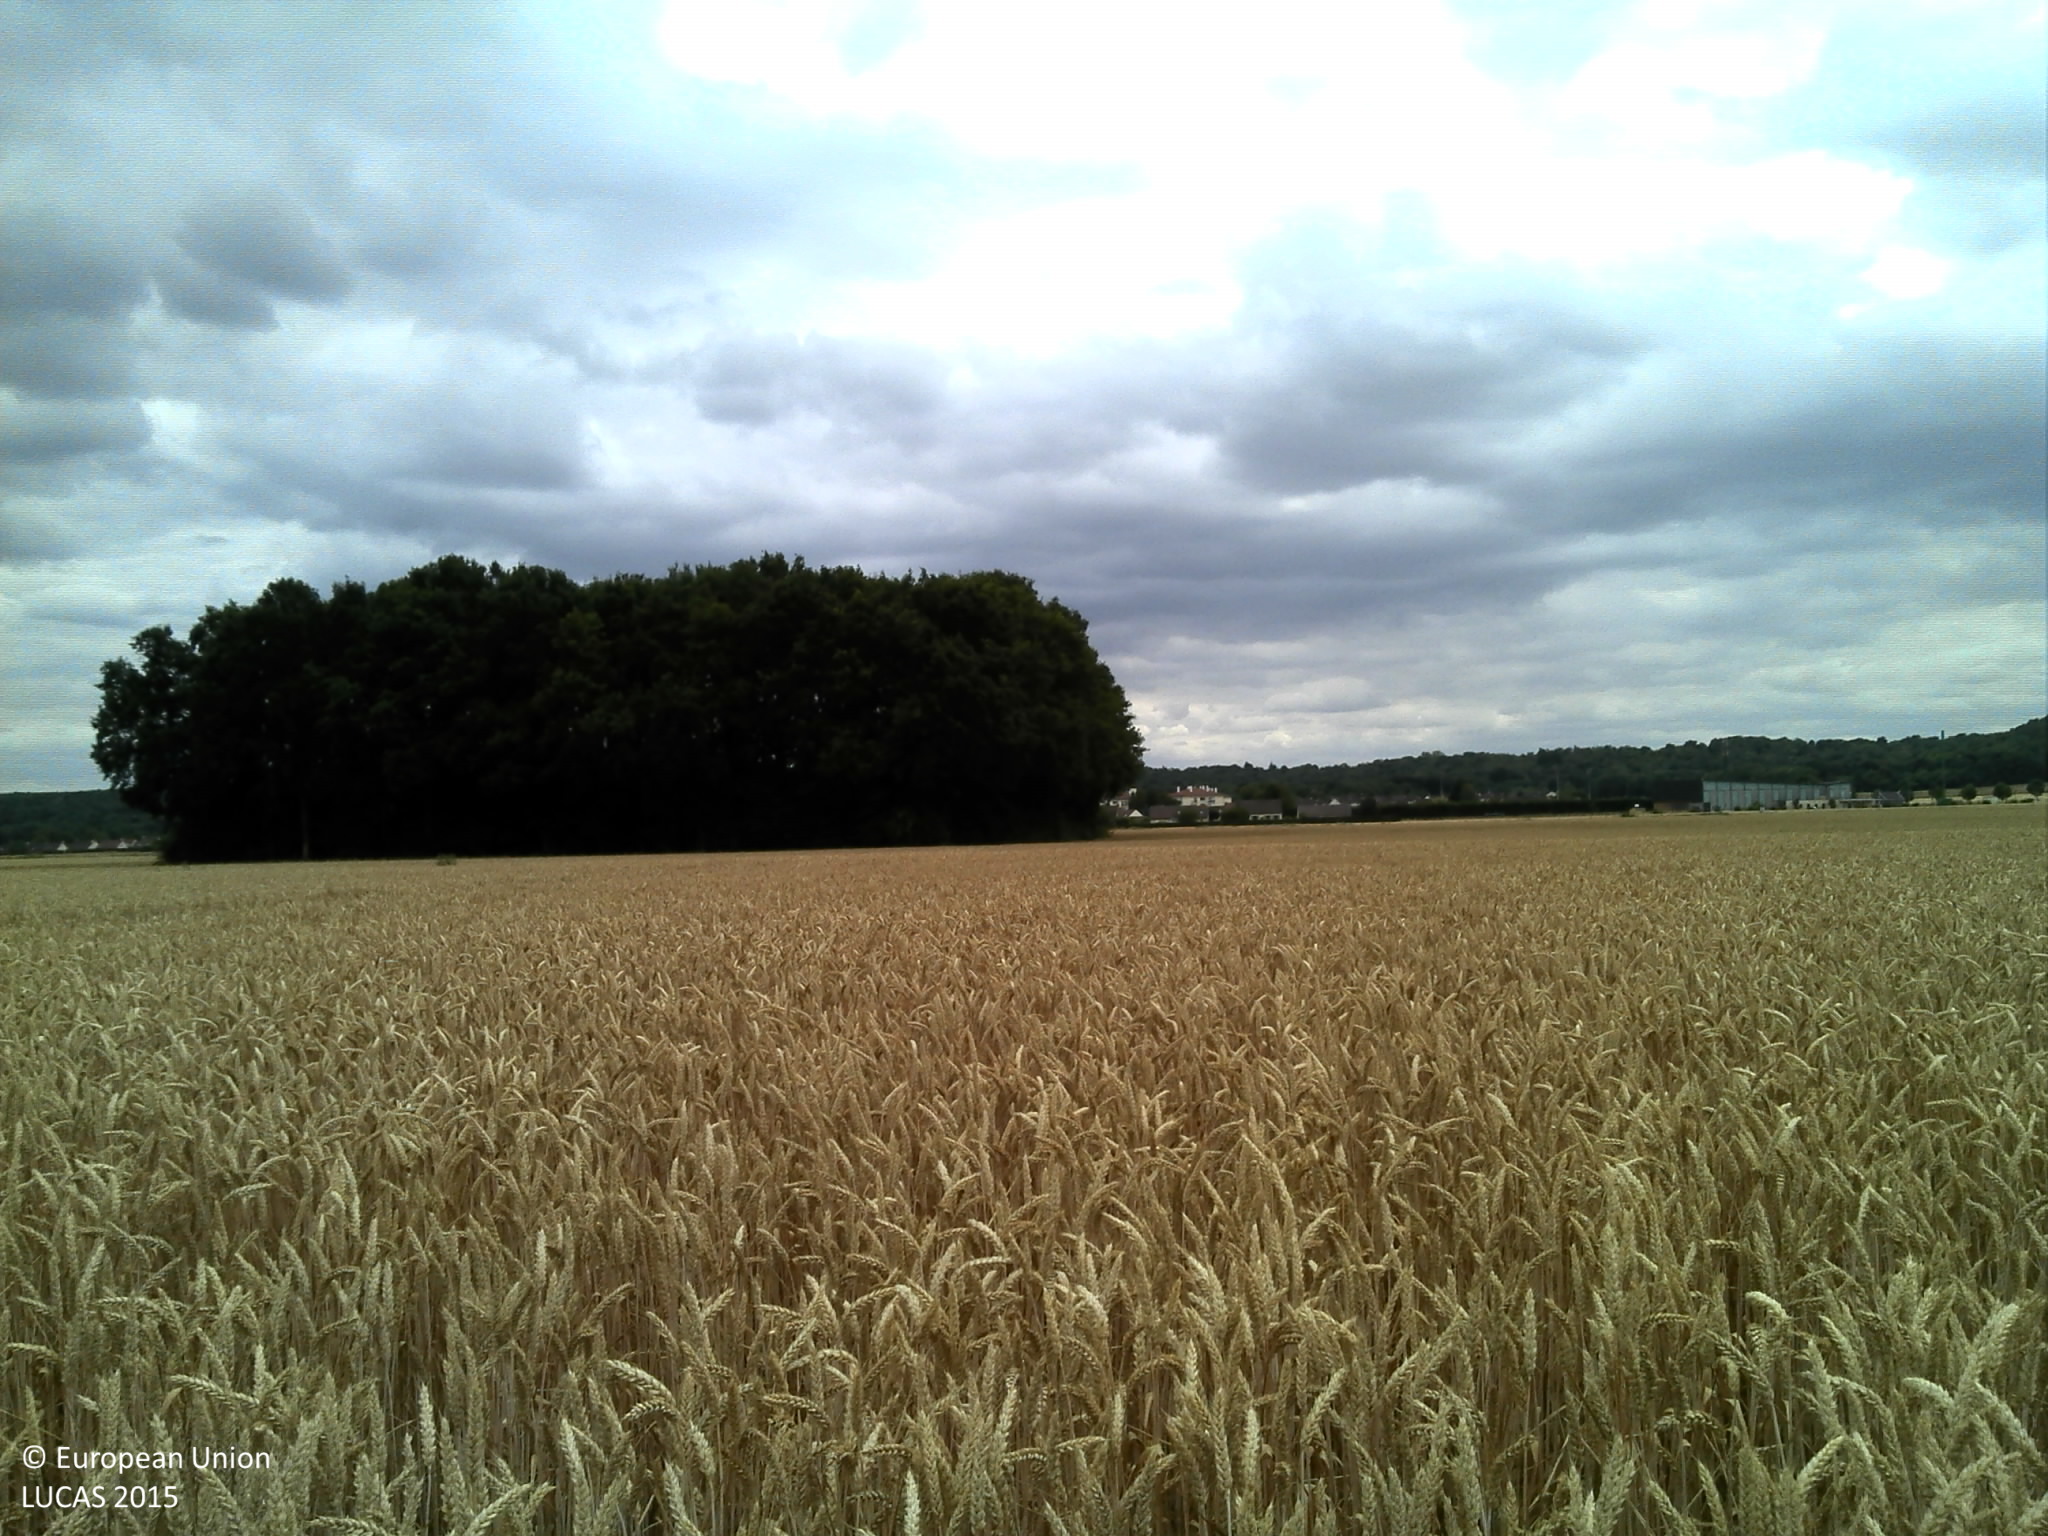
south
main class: Cropland
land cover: Common wheat
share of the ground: > 75 %
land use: Agriculture (excluding fallow land and kitchen gardens)
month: July
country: FR
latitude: 48.5245
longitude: 2.4471
